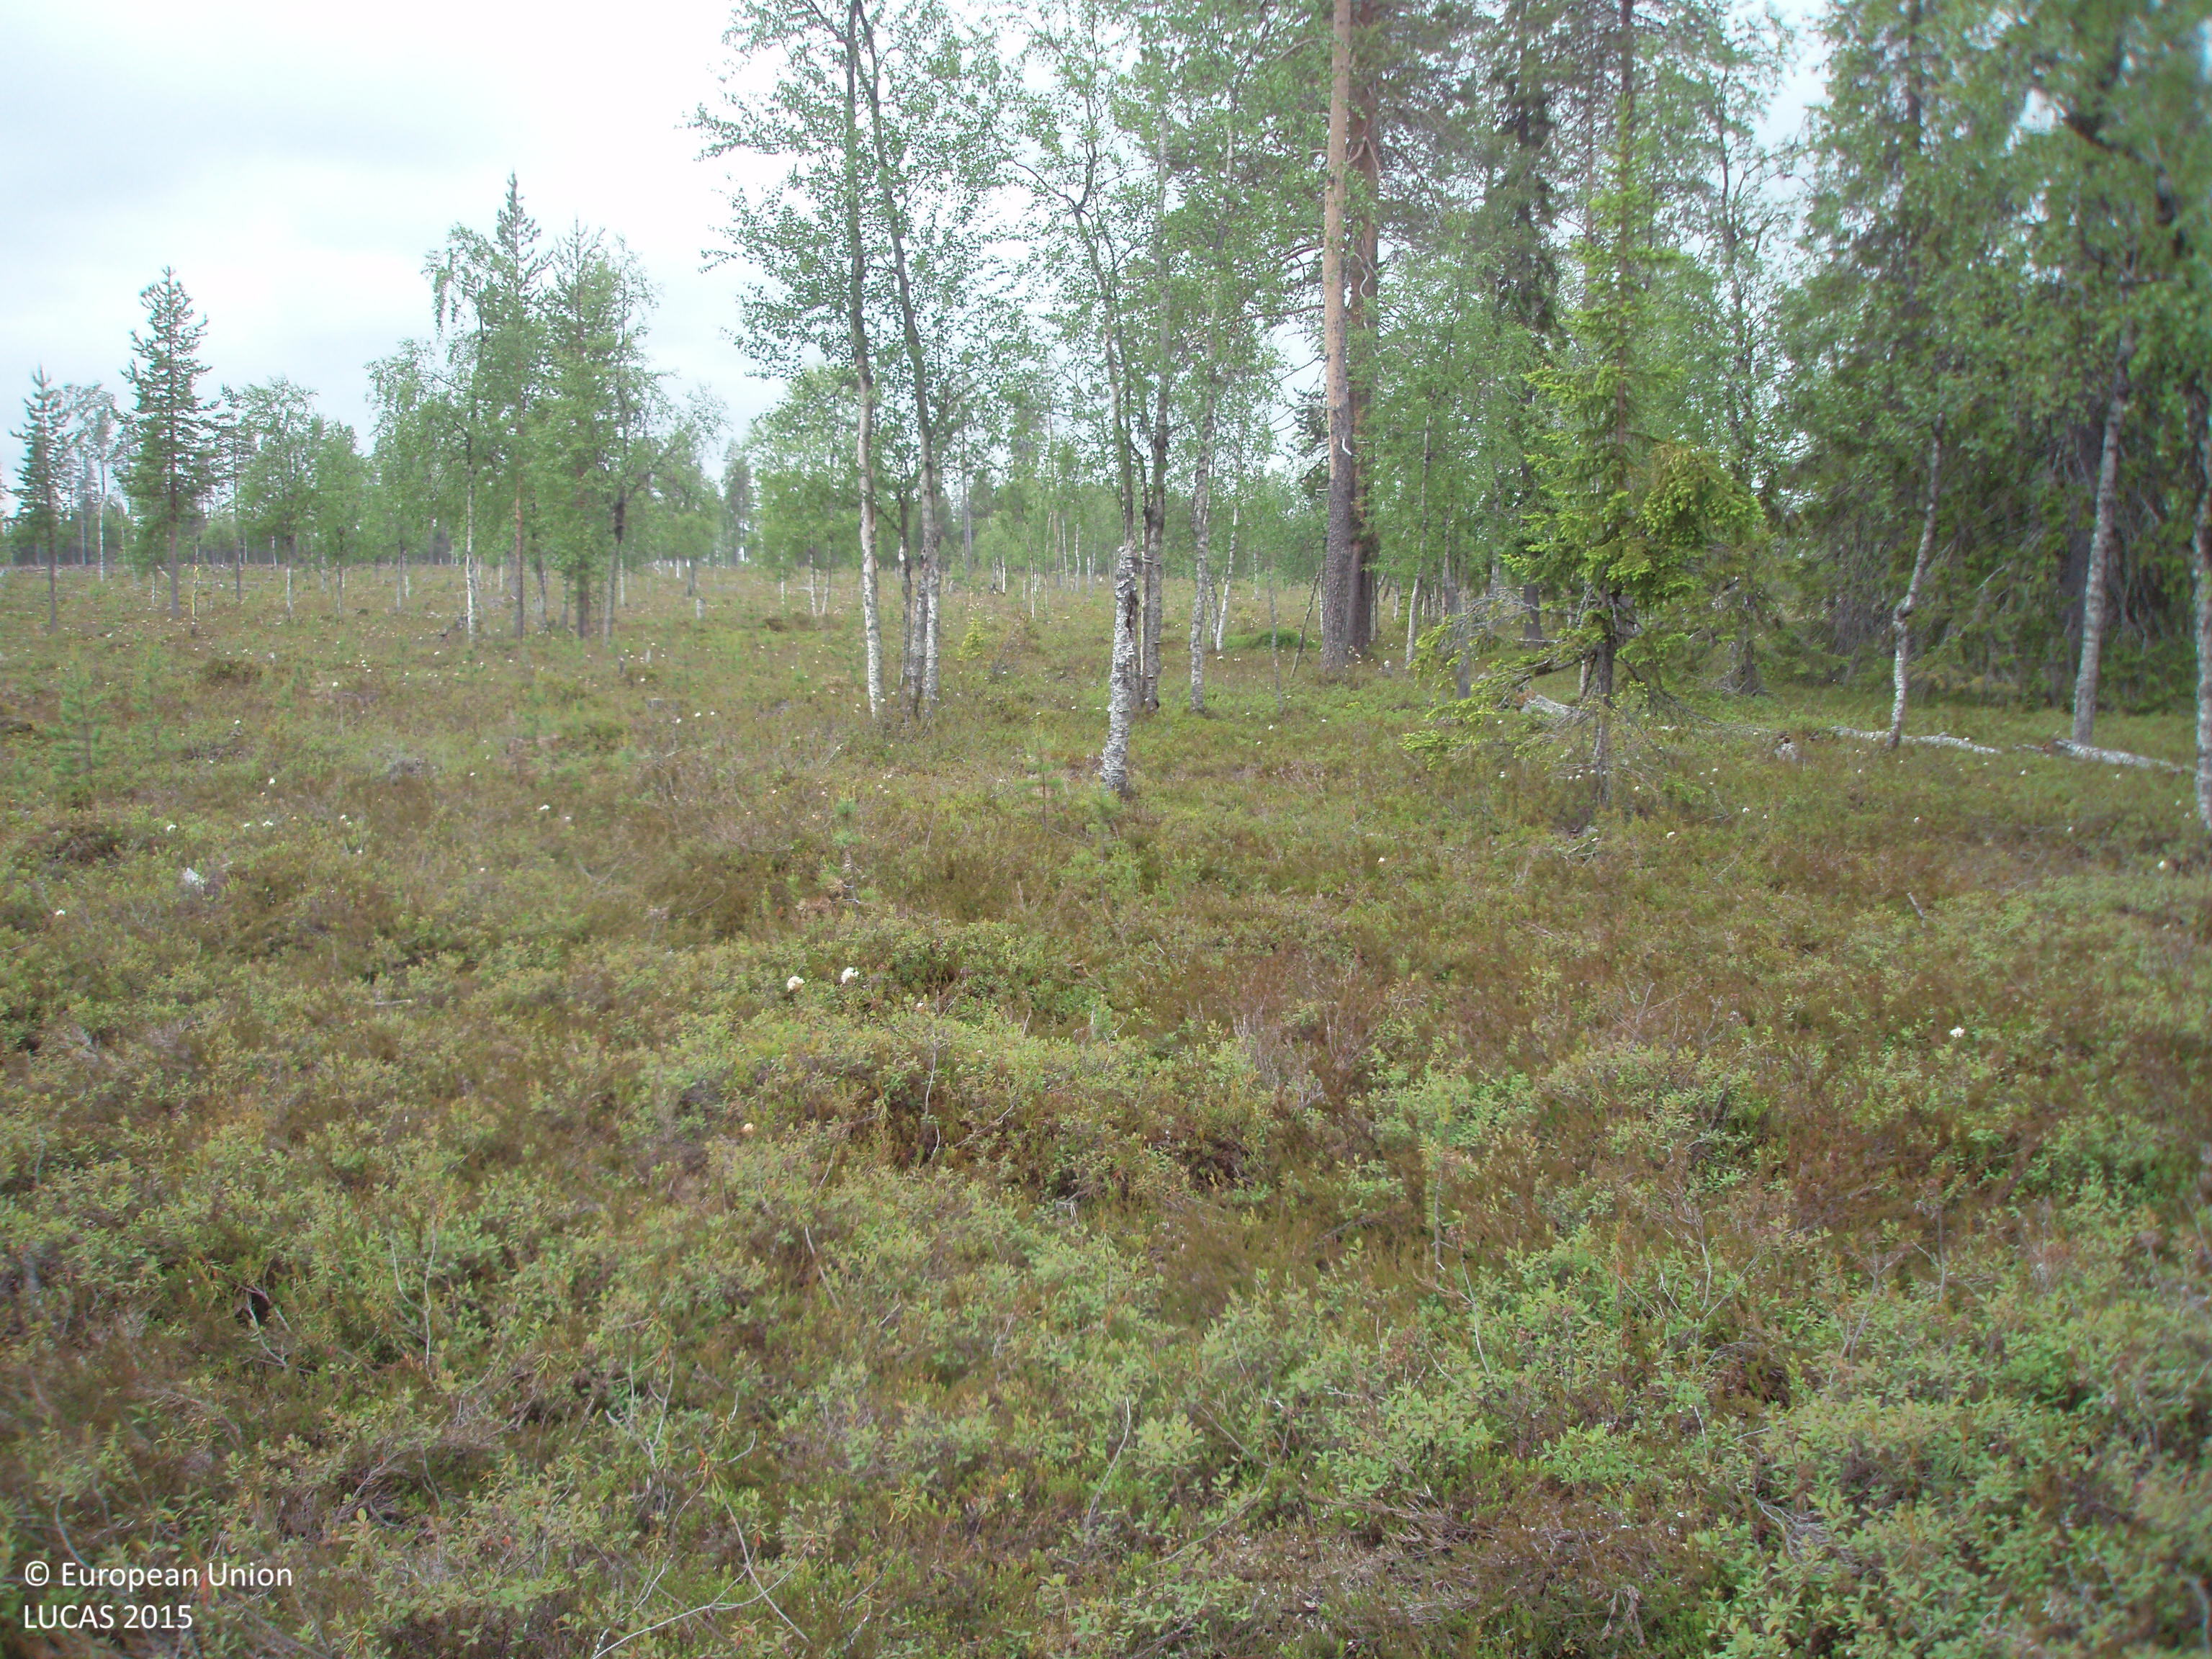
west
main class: Woodland
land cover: Pine dominated mixed woodland
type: boreal forest
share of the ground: 25 - 50 %
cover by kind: shrubs 60 %, coniferous forest trees 20 %, broadleaved forest trees 20 %
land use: Forestry
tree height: > 5 m
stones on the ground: 10 - 25 %
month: July
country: FI
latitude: 67.6828
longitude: 28.6060
